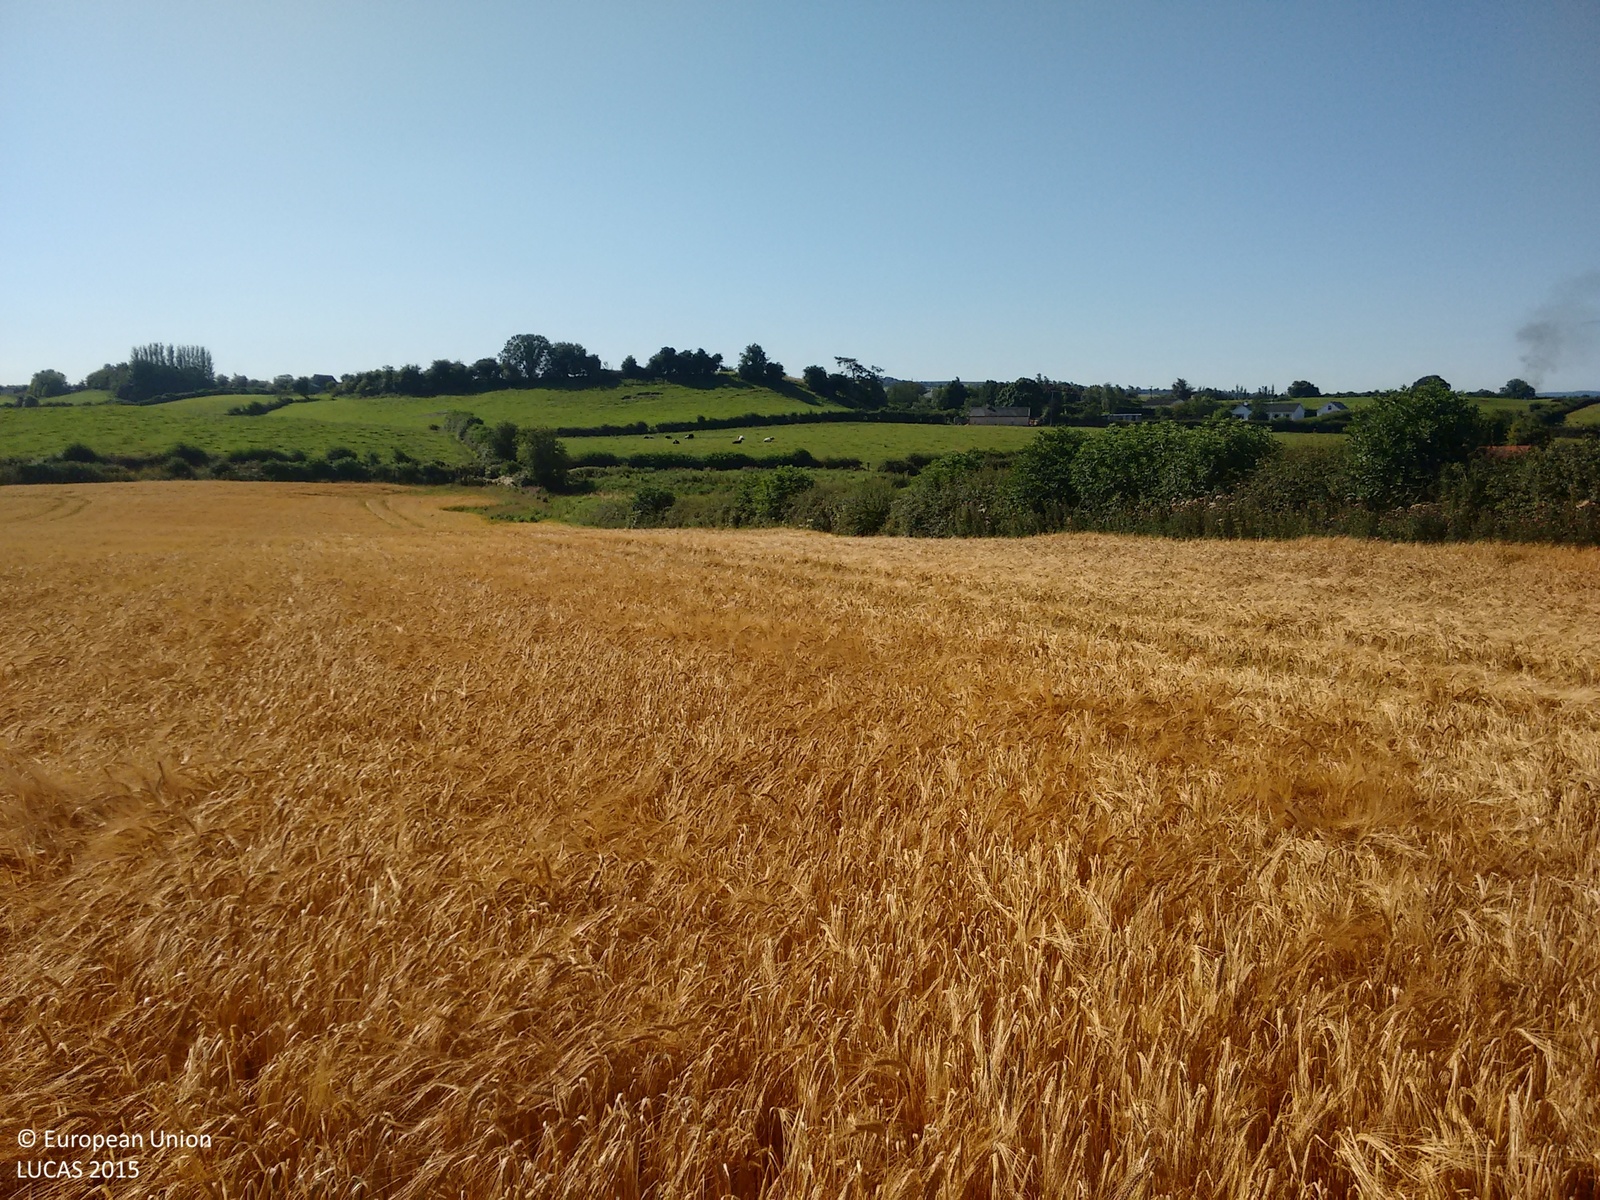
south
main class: Cropland
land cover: Barley
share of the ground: > 75 %
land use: Agriculture (excluding fallow land and kitchen gardens)
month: August
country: IE
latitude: 52.9687
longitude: -7.8137
